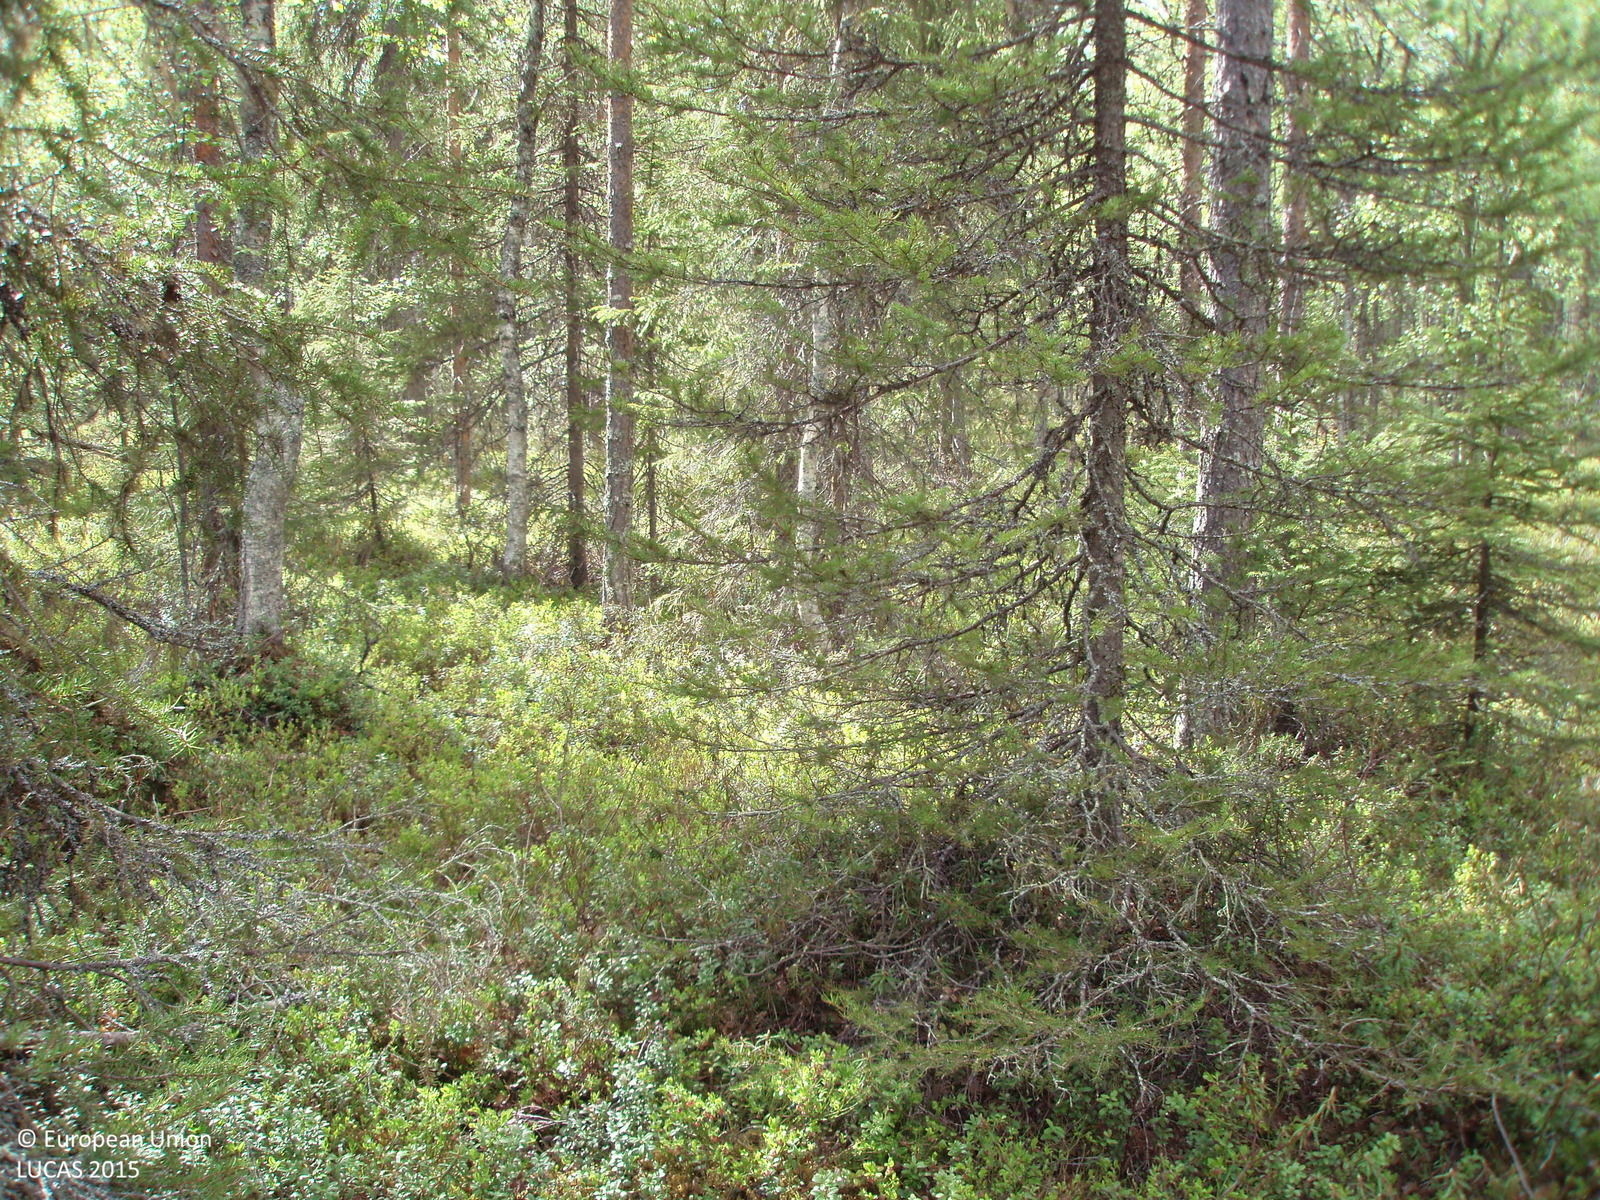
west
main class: Woodland
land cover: Other mixed woodland
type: boreal forest
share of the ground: 50 - 75 %
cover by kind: coniferous forest trees 40 %, broadleaved forest trees 30 %, shrubs 30 %
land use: Forestry
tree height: > 5 m
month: June
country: FI
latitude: 67.0409
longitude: 27.2124
